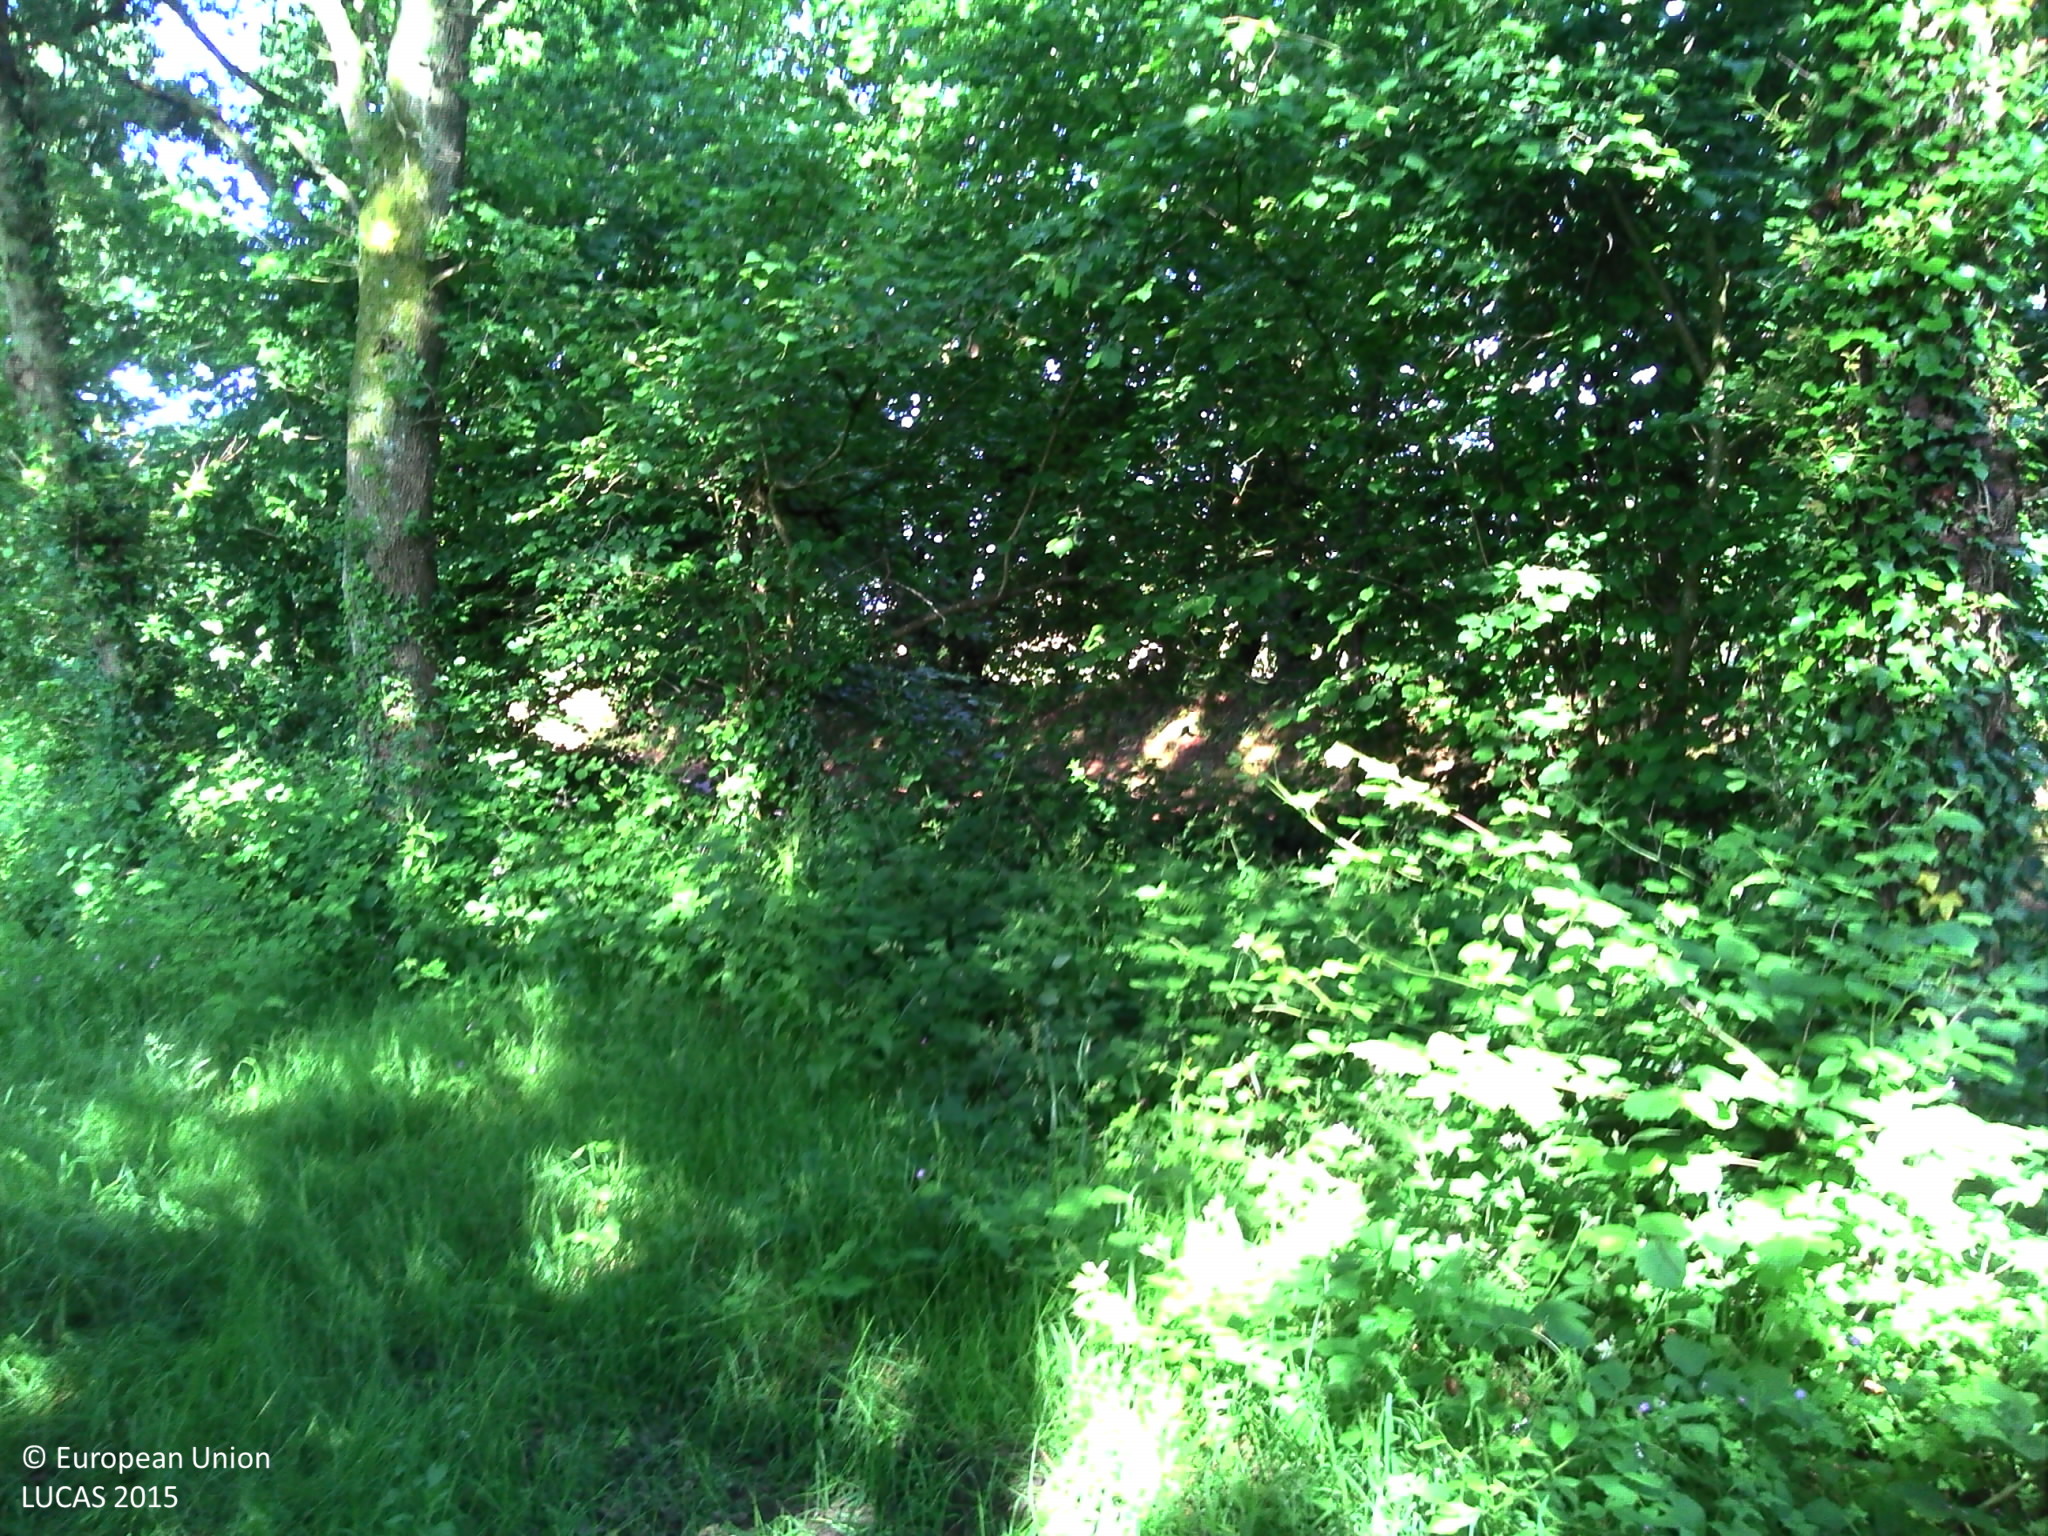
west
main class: Woodland
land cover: Broadleaved woodland
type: acidophilous oak and oak-birch forest
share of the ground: > 75 %
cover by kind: broadleaved forest trees 90 %, herbaceous plants 10 %
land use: Forestry
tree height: > 5 m
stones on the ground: < 10 %
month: June
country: FR
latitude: 49.2882
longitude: -1.5295
